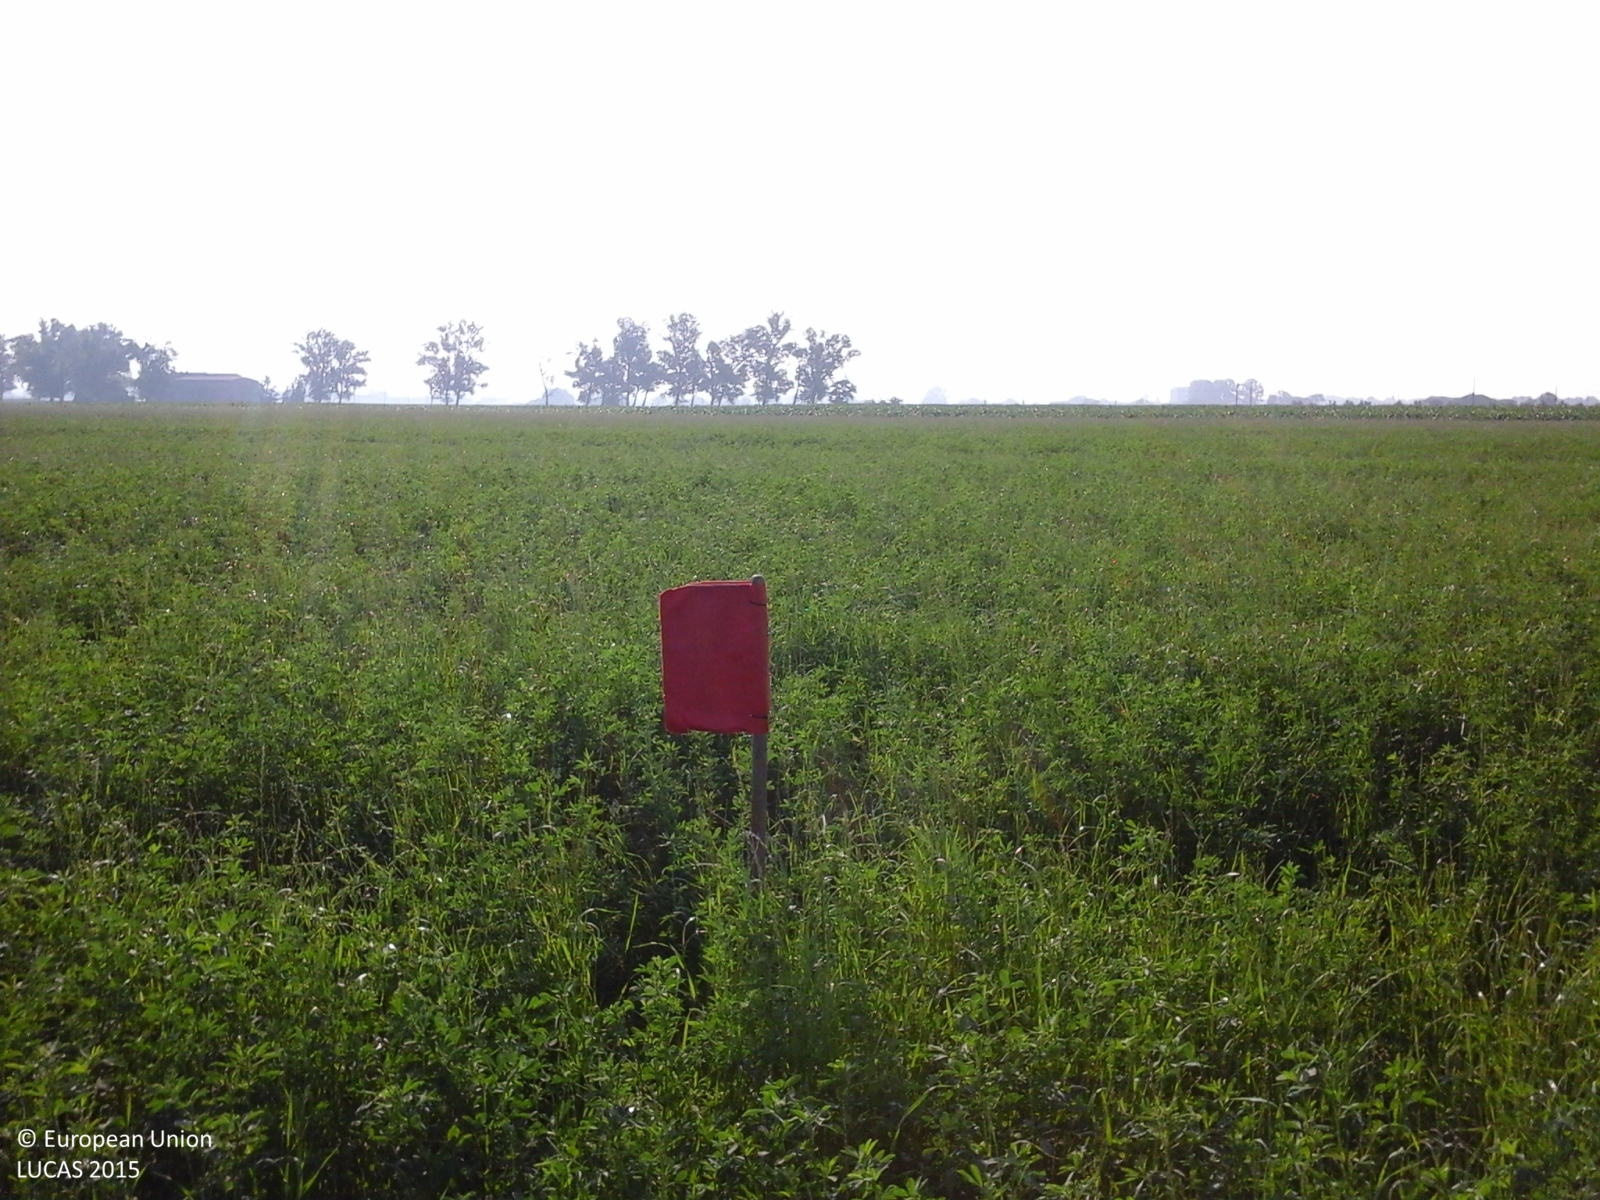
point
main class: Cropland
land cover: Lucerne
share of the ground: > 75 %
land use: Agriculture (excluding fallow land and kitchen gardens)
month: June
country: IT
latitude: 44.9815
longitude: 10.1898
